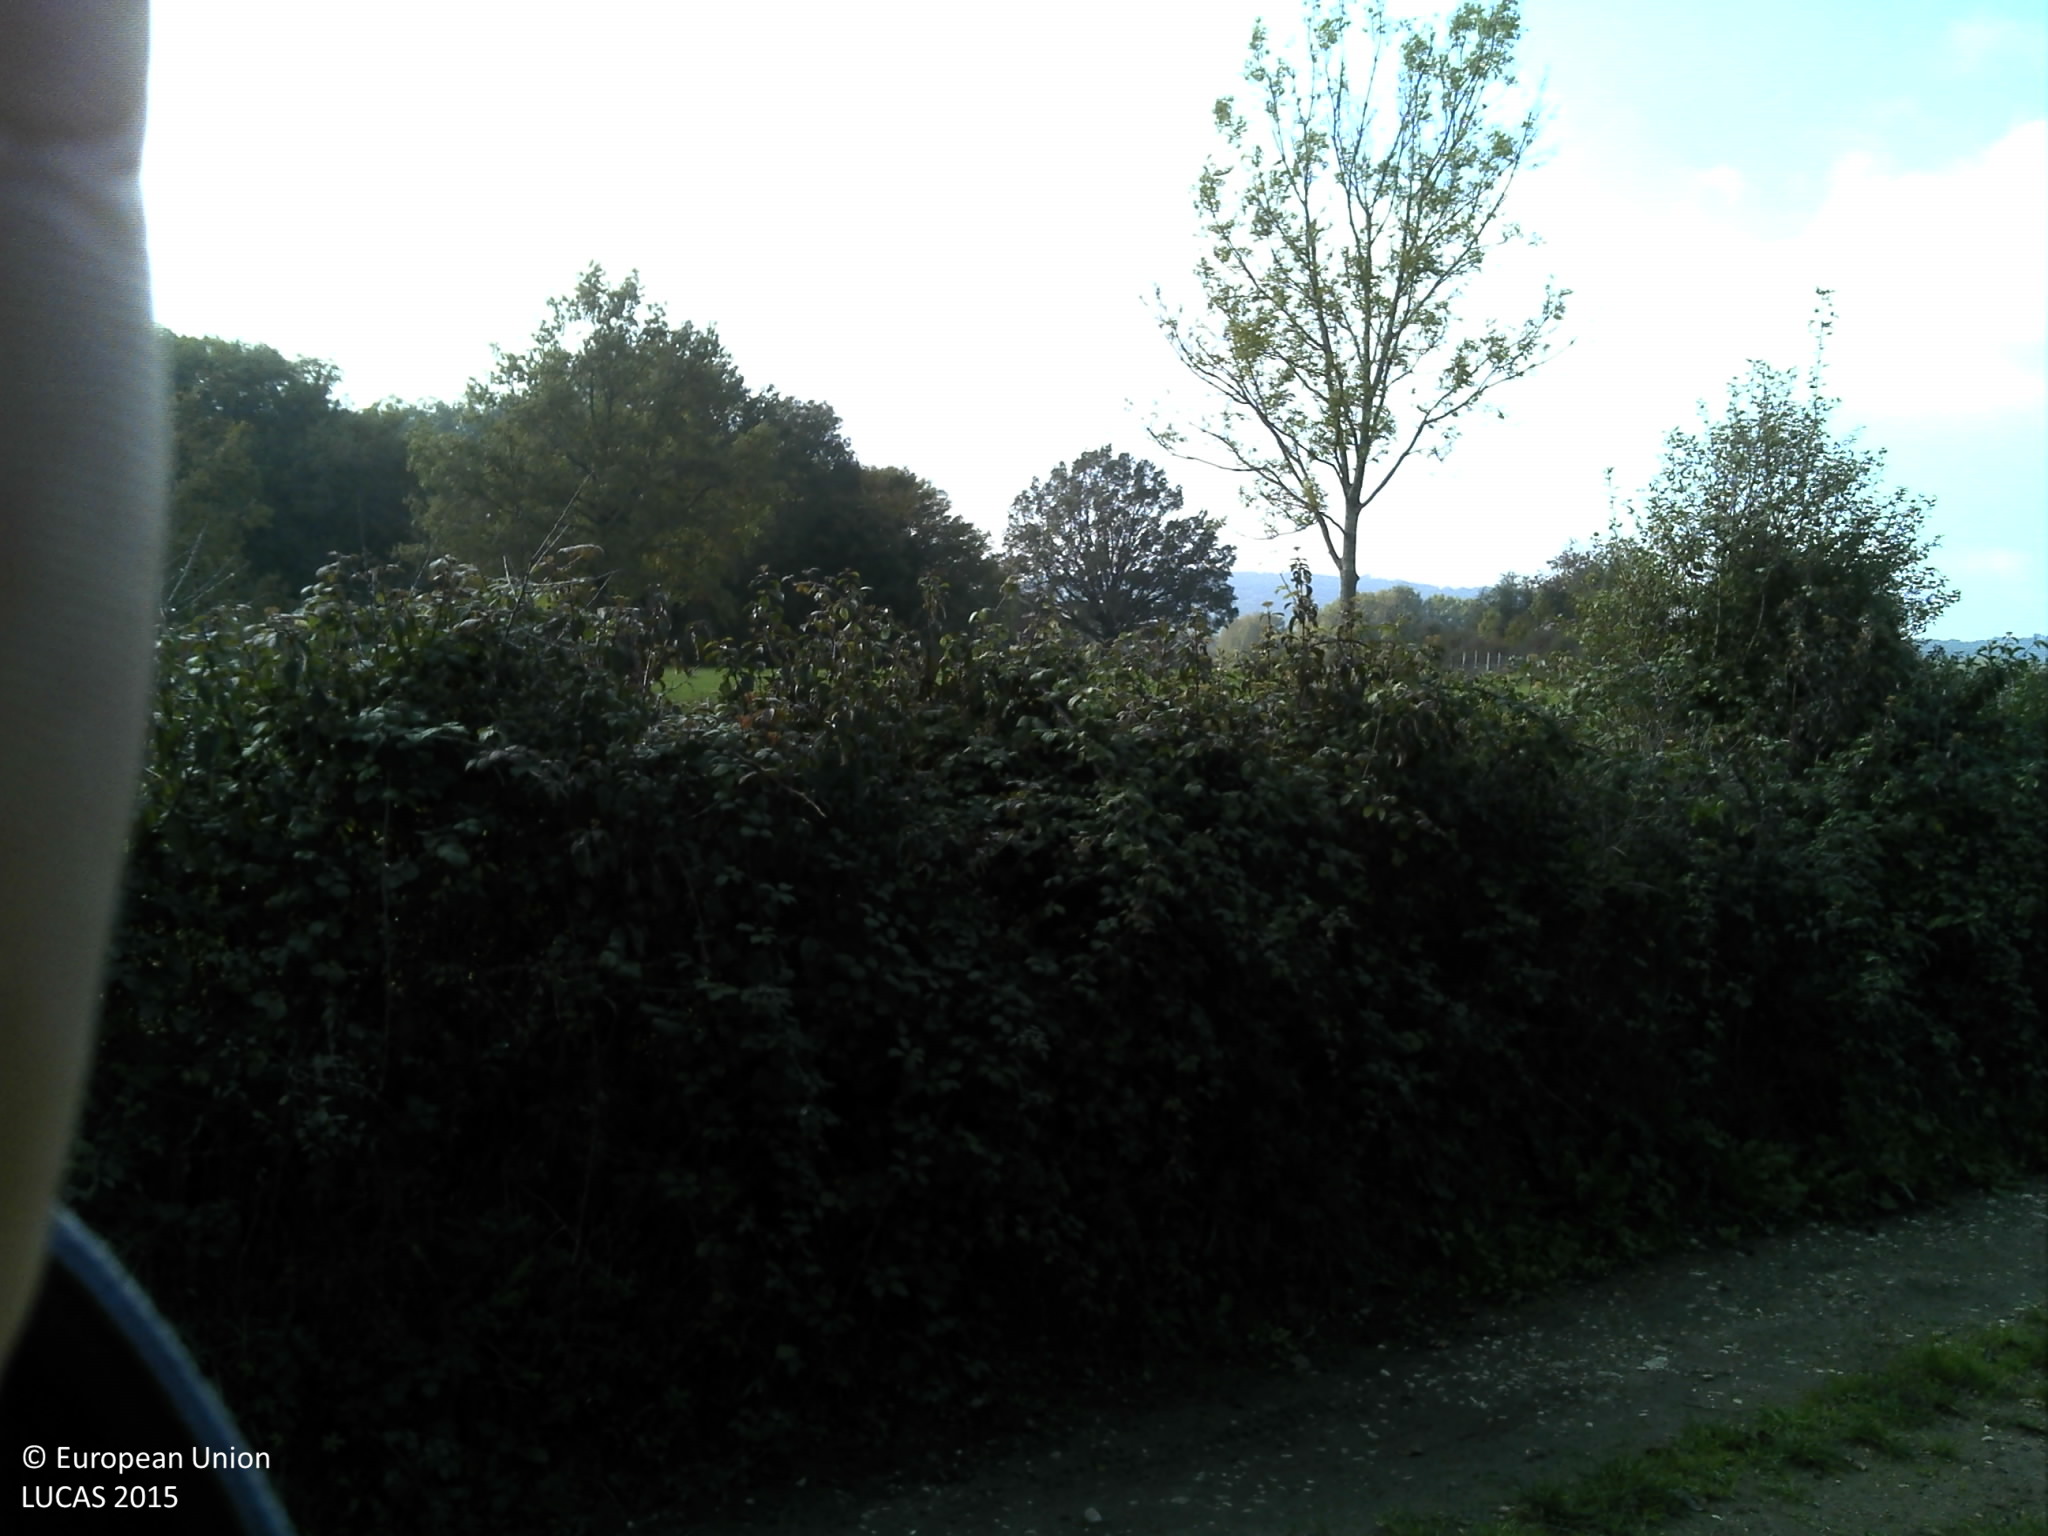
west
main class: Grassland
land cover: Grassland without tree/shrub cover
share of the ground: > 75 %
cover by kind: herbaceous plants 100 %
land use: Agriculture (excluding fallow land and kitchen gardens)
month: October
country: FR
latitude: 46.1433
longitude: 5.3816
